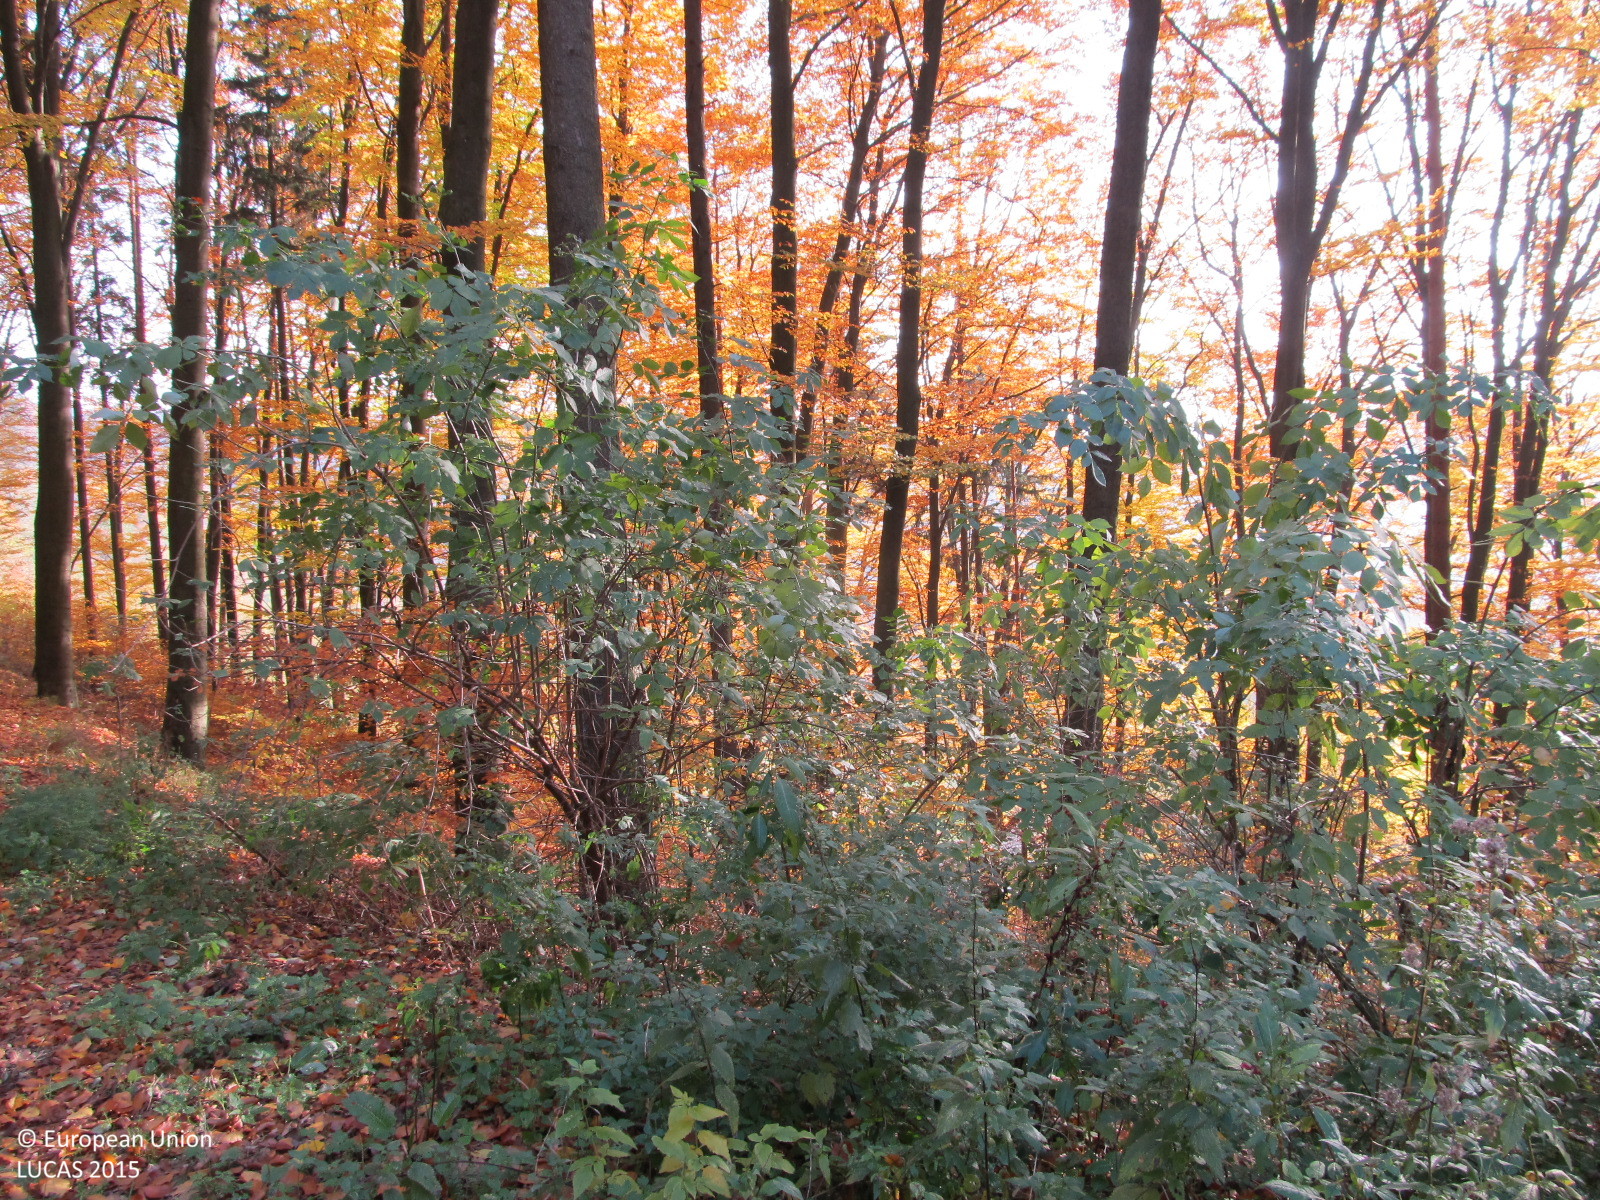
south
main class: Woodland
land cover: Spruce dominated mixed woodland
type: hemiboreal forest and nemoral coniferous forest and mixed broadleaved-coniferous forest
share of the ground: > 75 %
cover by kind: broadleaved forest trees 50 %, coniferous forest trees 30 %, shrubs 15 %, herbaceous plants 5 %
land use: Forestry
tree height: > 5 m
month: October
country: AT
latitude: 48.2507
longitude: 15.4568
